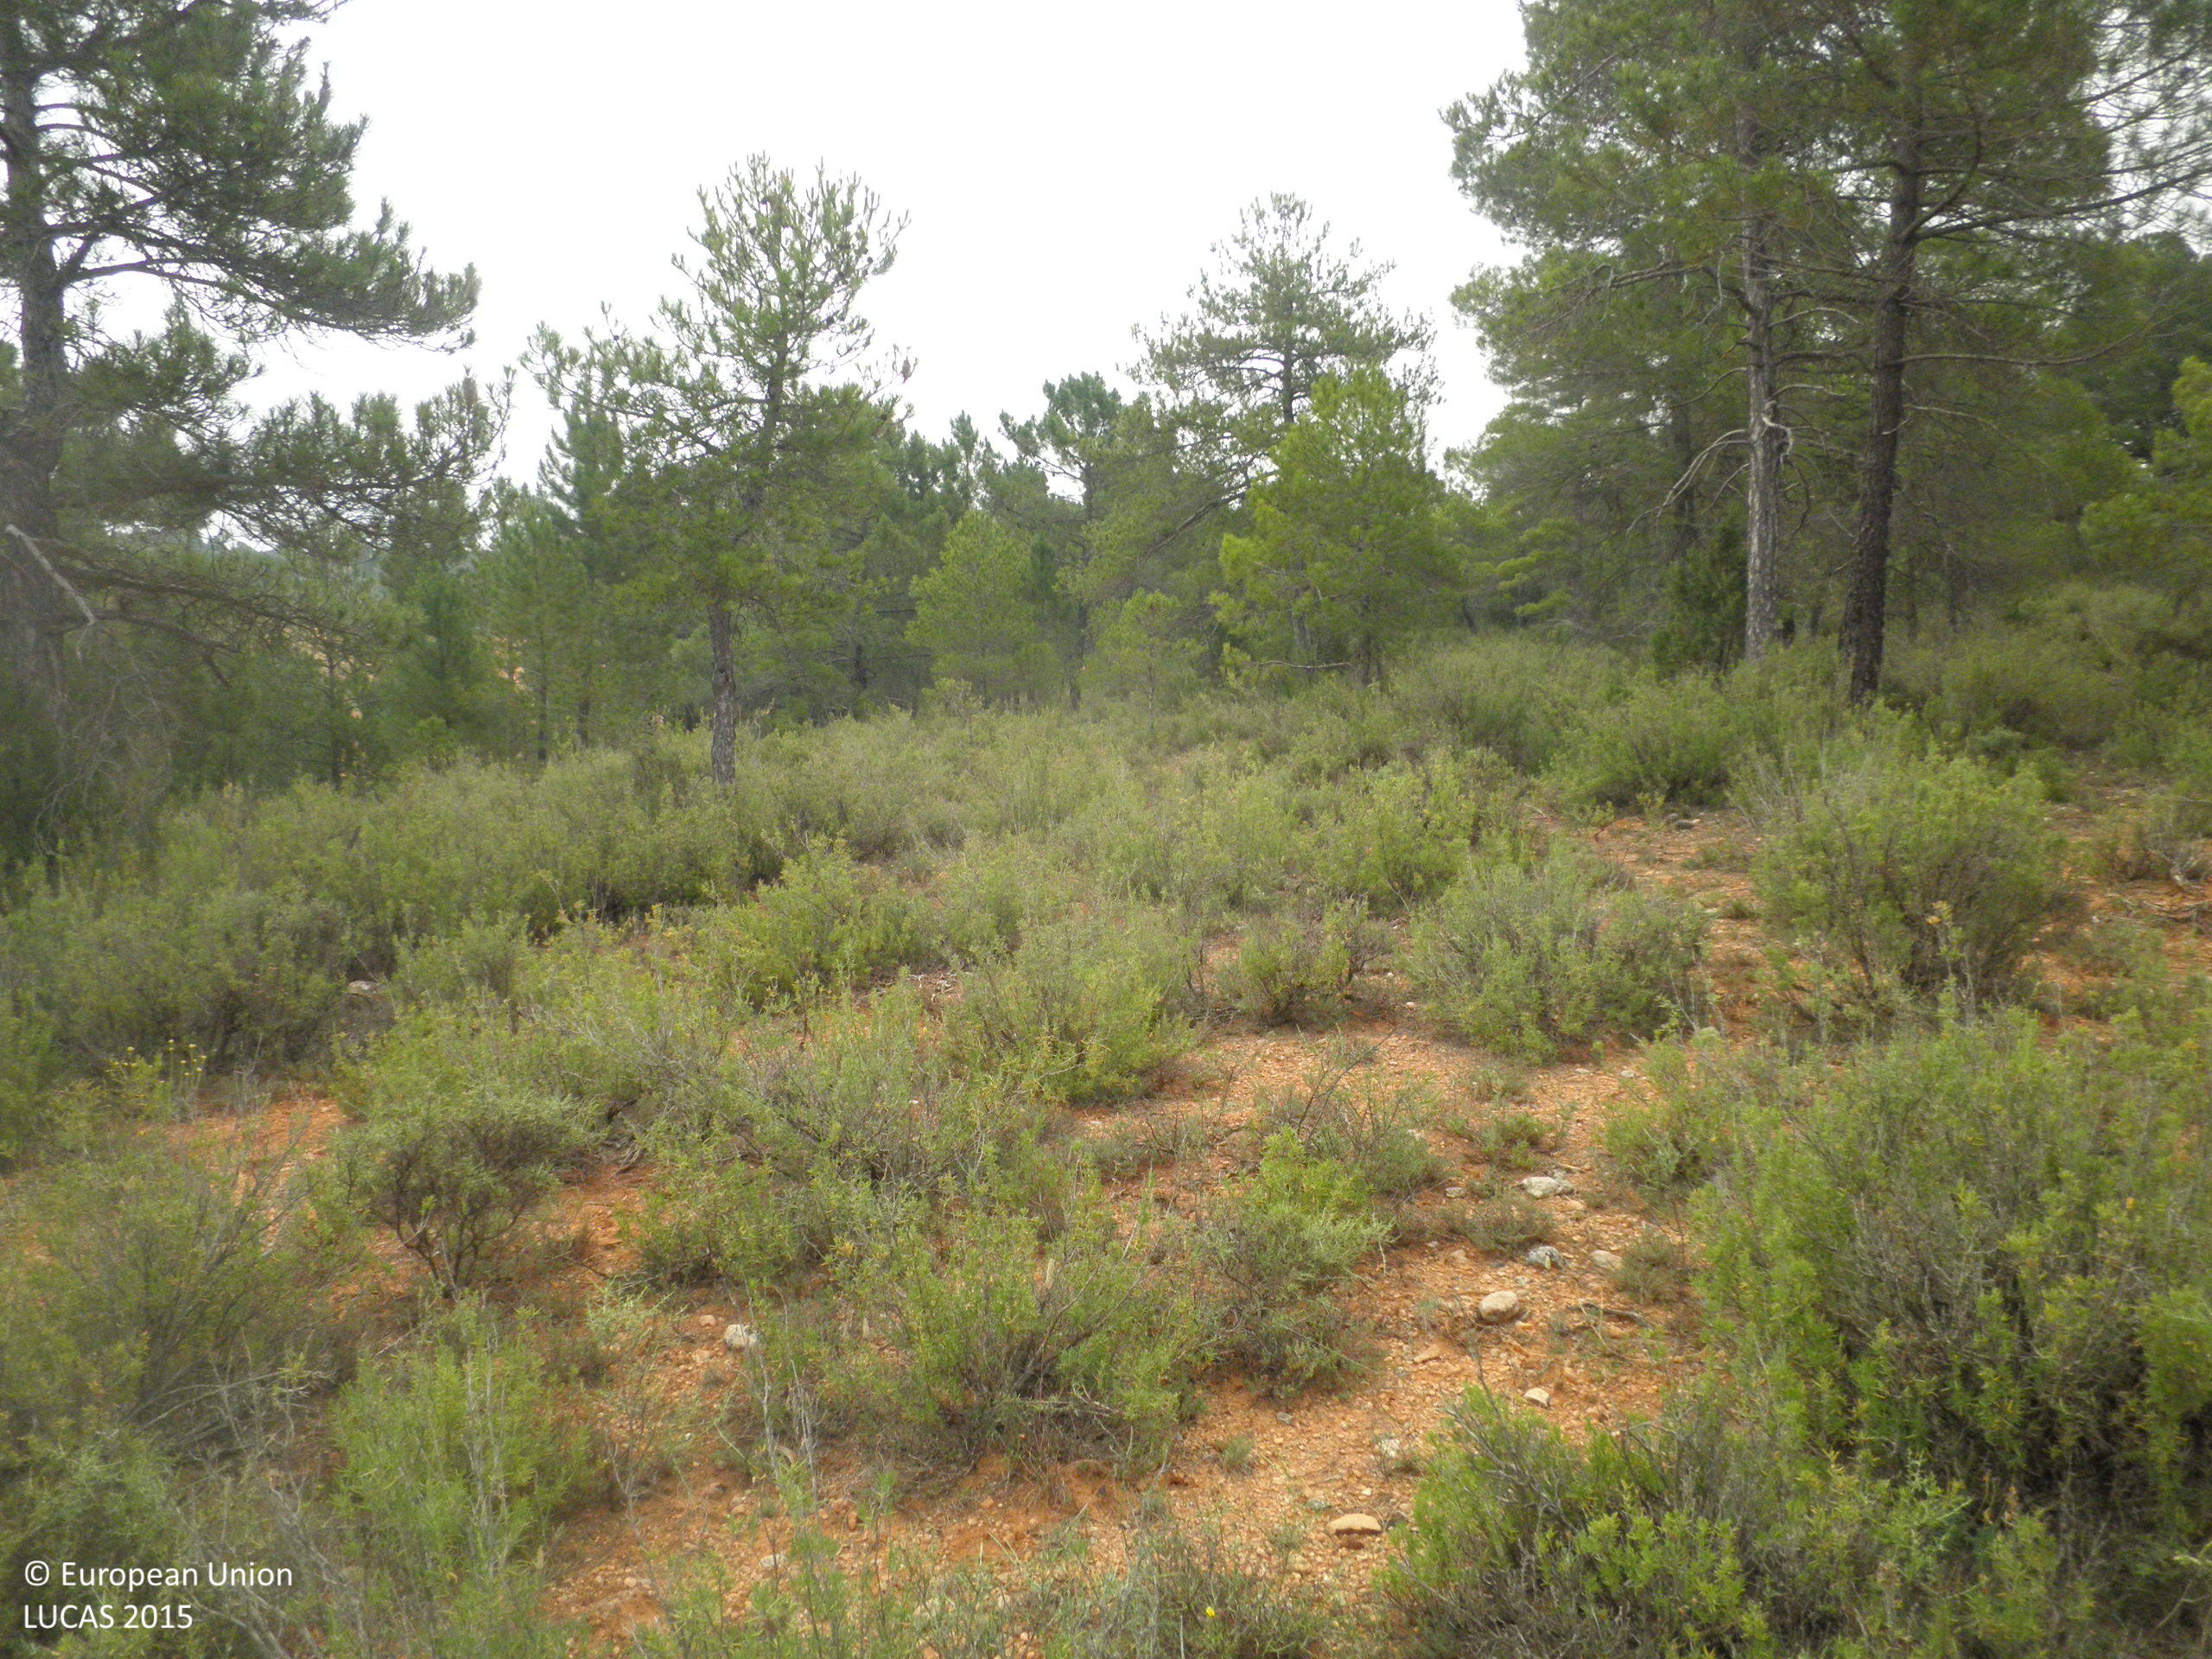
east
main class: Woodland
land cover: Pine dominated coniferous woodland
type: coniferous forest of the mediterranean region
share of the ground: 25 - 50 %
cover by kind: shrubs 60 %, coniferous forest trees 25 %, unconsolidated bare surface 15 %
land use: Semi-natural and natural areas not in use
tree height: > 5 m
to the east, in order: Pine dominated coniferous woodland; Tracks; Pine dominated coniferous woodland; Dry pulses; Broadleaved woodland; Dry pulses; Broadleaved woodland; Tracks; Grass margins; Dry pulses
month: June
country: ES
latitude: 39.5587
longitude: -1.7500
